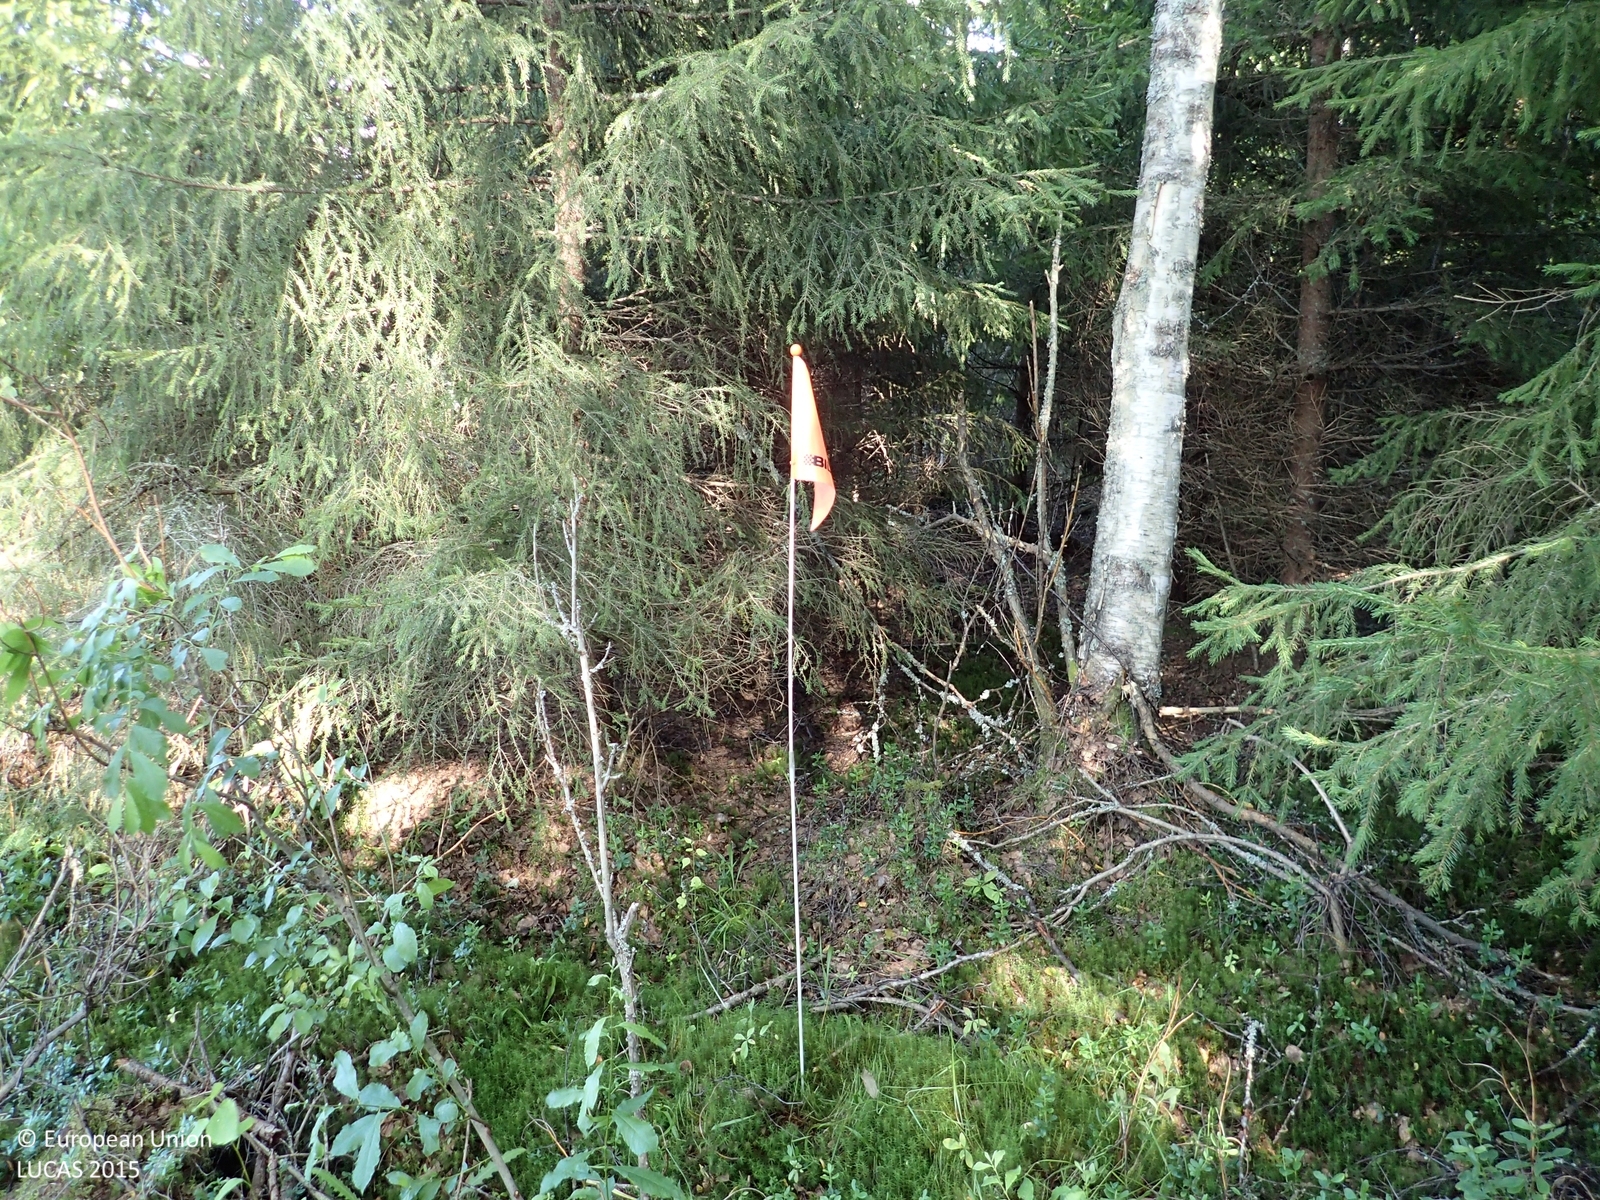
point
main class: Woodland
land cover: Spruce dominated mixed woodland
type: boreal forest
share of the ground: > 75 %
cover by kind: coniferous forest trees 50 %, broadleaved forest trees 30 %, shrubs 10 %, lichens and mosses 10 %
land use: Forestry
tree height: > 5 m
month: August
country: FI
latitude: 62.6450
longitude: 21.9666
